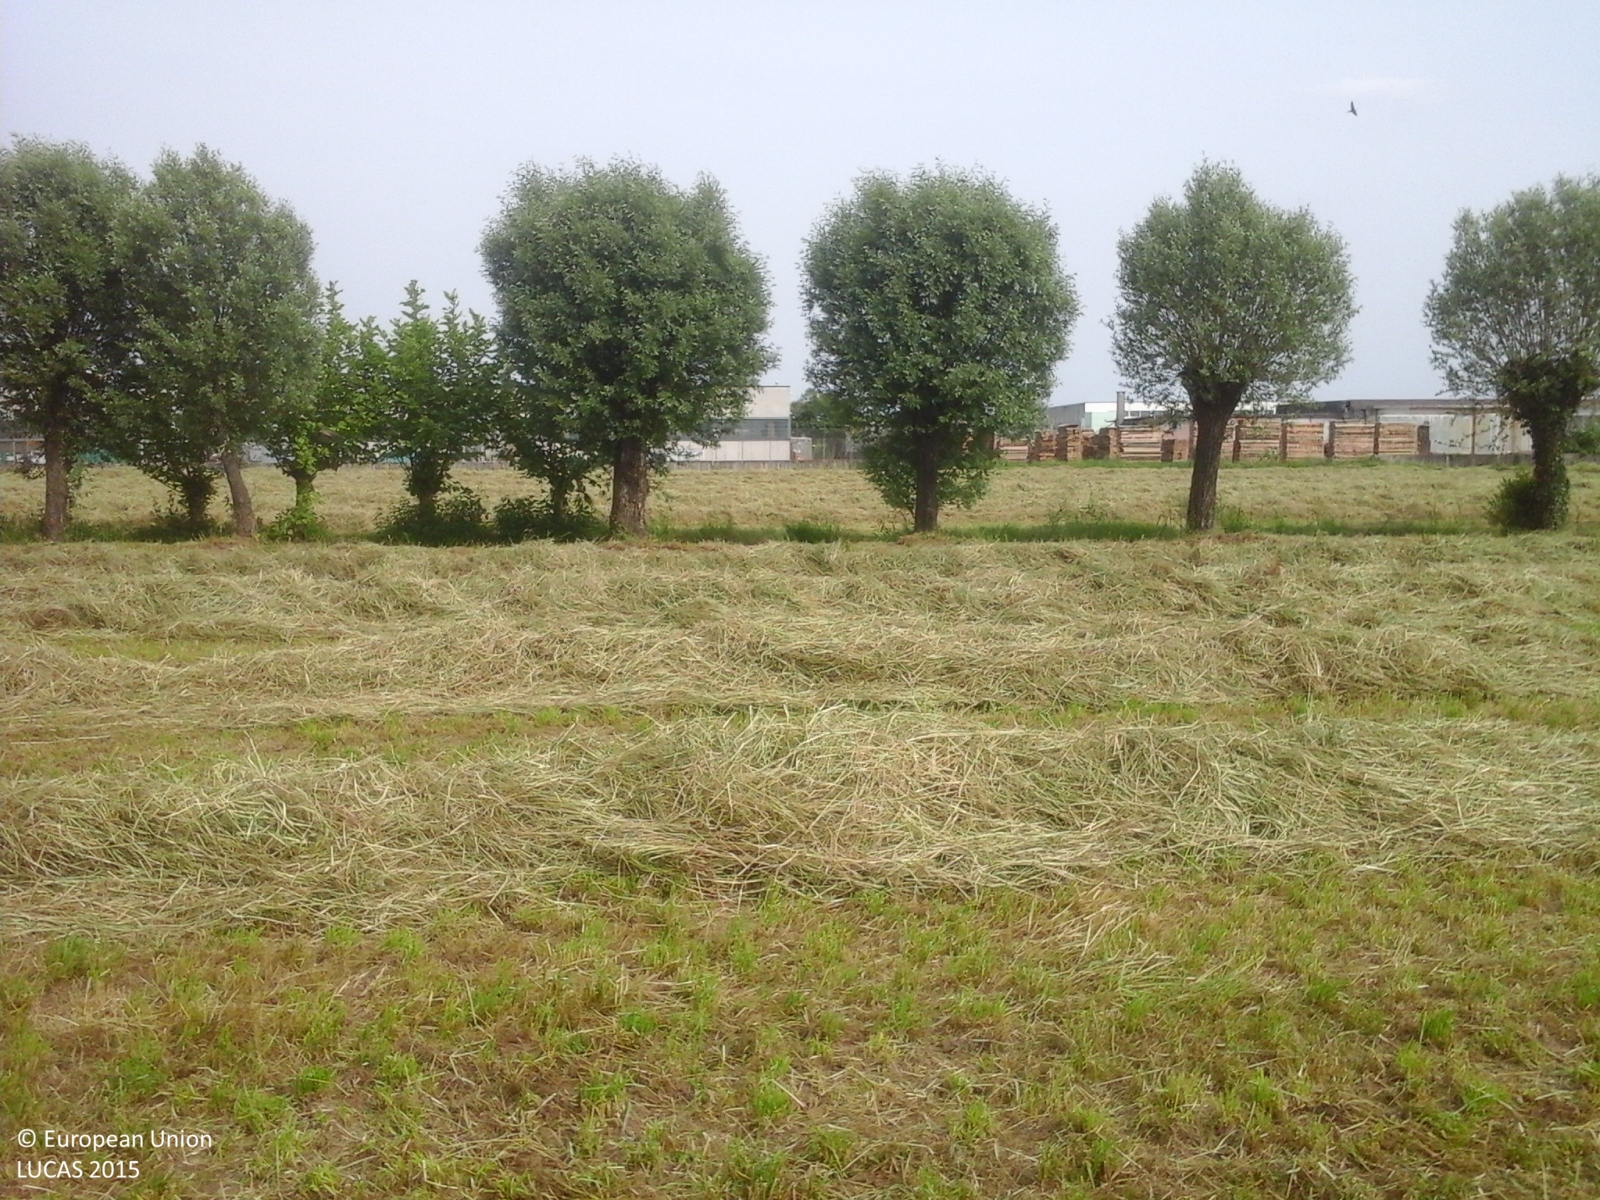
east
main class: Cropland
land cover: Temporary grasslands
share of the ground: > 75 %
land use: Agriculture (excluding fallow land and kitchen gardens)
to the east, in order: Temporary grasslands; Managed hedges; Ditches and canals; Managed hedges; Grassland without tree/shrub cover; Artificial constructions in urban areas
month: May
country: IT
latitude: 45.6537
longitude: 11.6528
